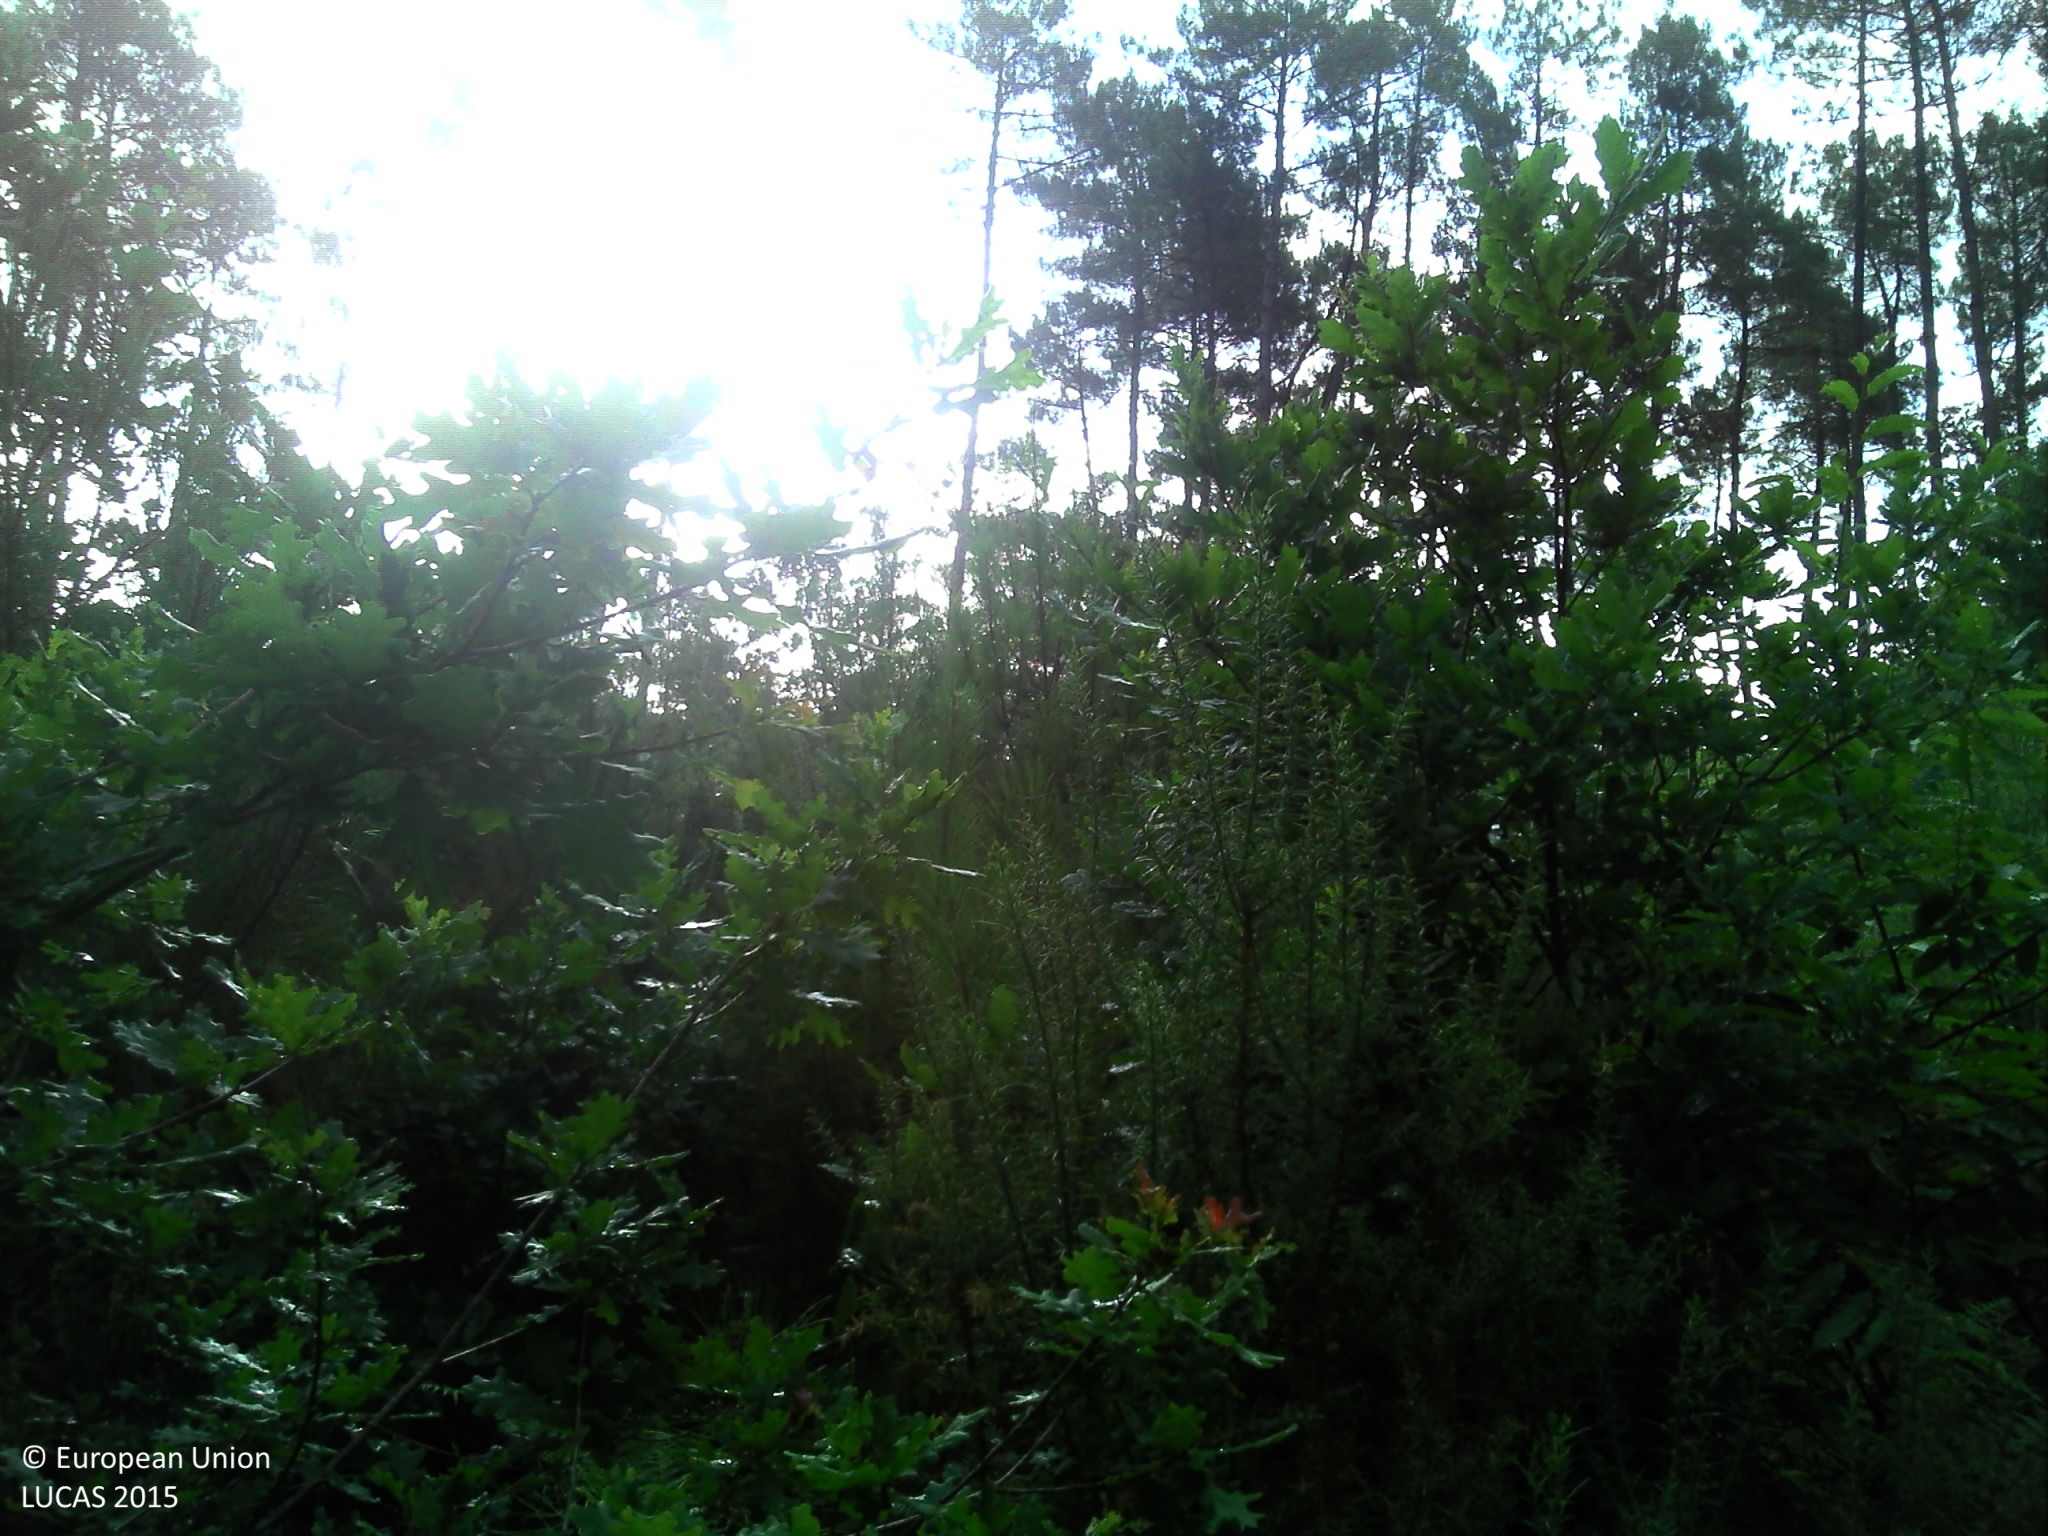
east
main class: Woodland
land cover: Pine dominated mixed woodland
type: coniferous forest of the mediterranean region
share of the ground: > 75 %
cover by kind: coniferous forest trees 50 %, broadleaved forest trees 25 %, herbaceous plants 15 %, shrubs 10 %
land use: Forestry
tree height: > 5 m
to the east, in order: Pine dominated mixed woodland; Pine dominated coniferous woodland; Rivers and streams; Broadleaved woodland; Grass margins; Tracks; Grass margins; Broadleaved woodland
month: July
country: FR
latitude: 44.0704
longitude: -1.1943
